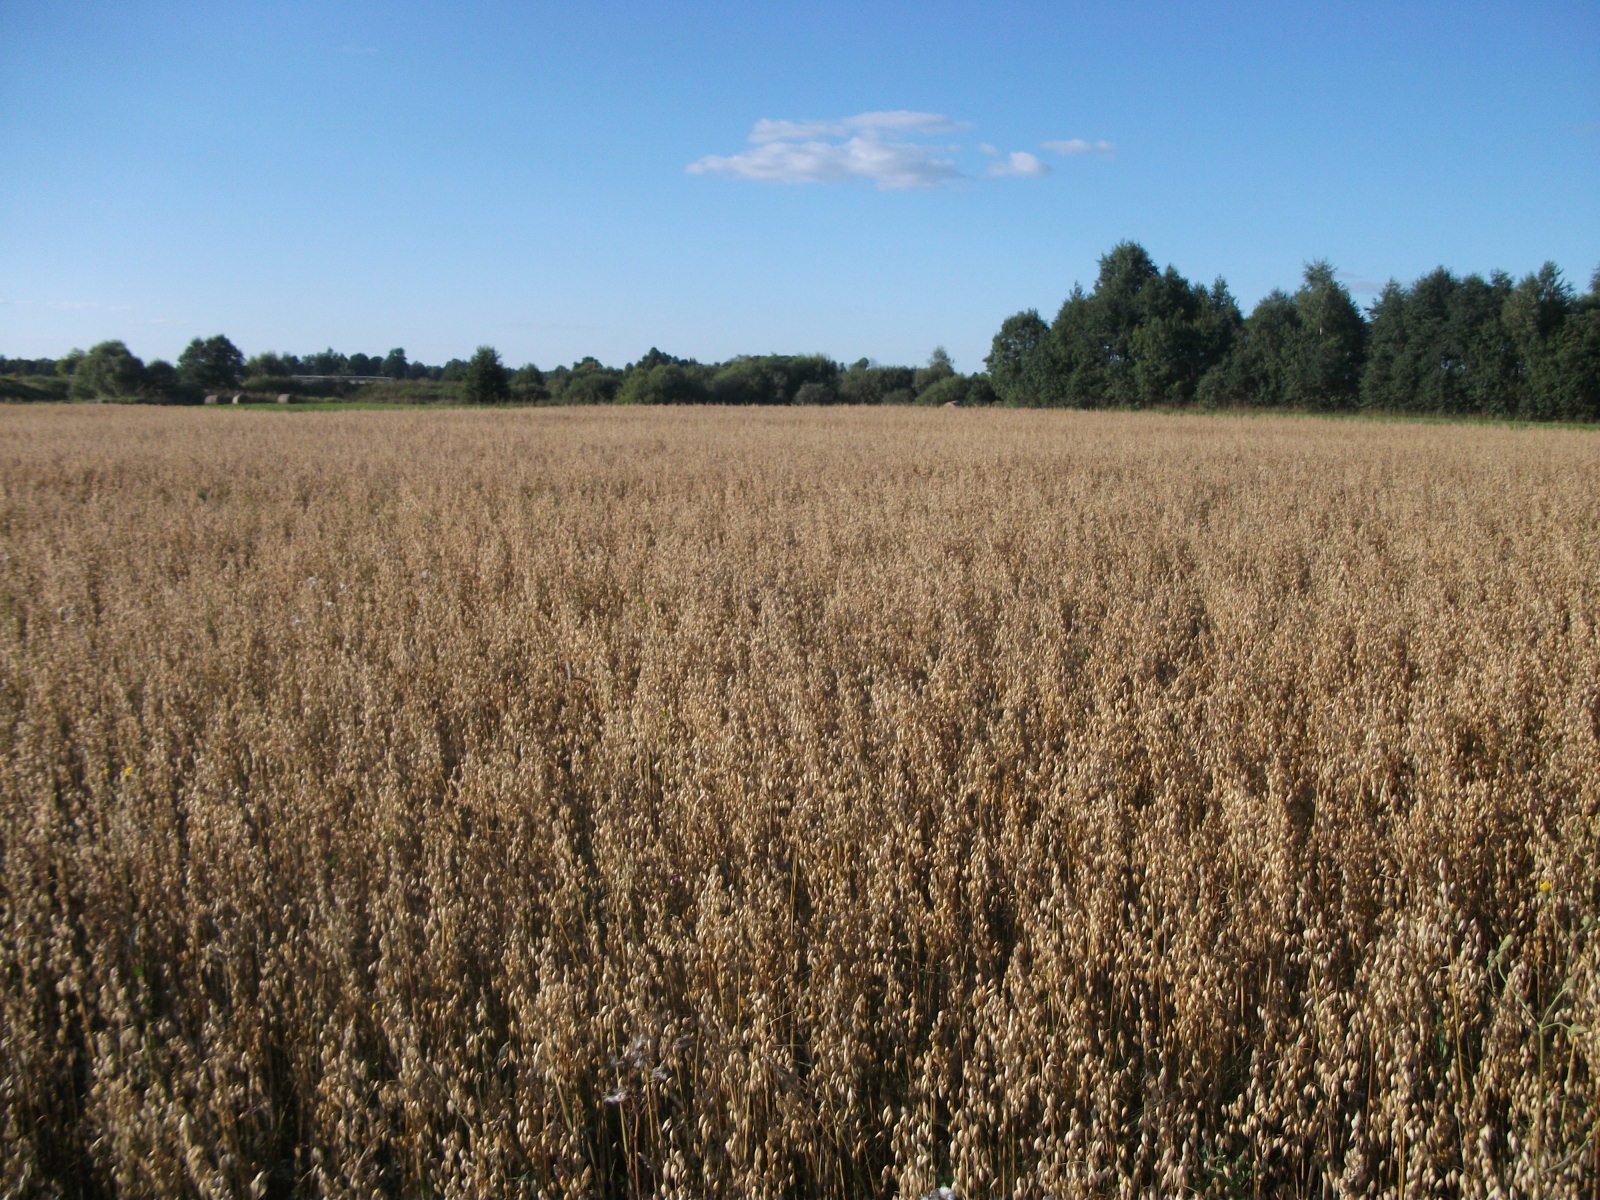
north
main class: Cropland
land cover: Oats
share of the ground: > 75 %
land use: Agriculture (excluding fallow land and kitchen gardens)
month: August
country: LV
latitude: 56.3612
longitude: 26.3464
